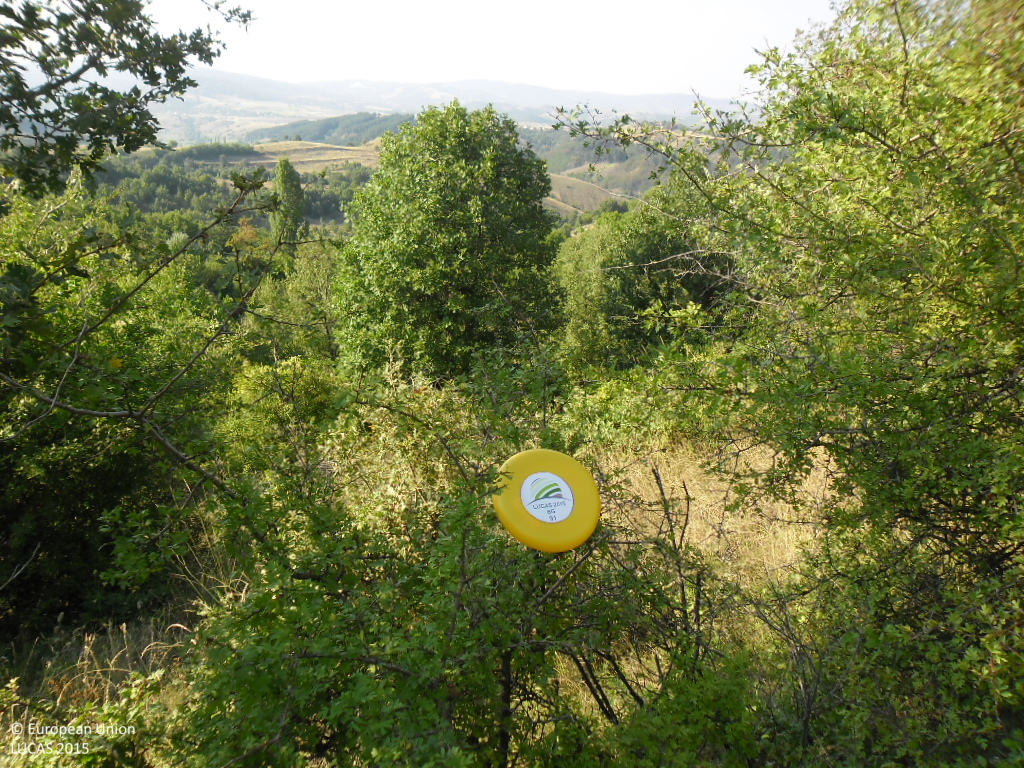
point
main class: Woodland
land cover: Broadleaved woodland
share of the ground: 50 - 75 %
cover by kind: broadleaved forest trees 70 %, herbaceous plants 20 %, shrubs 10 %
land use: Forestry
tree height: < 5 m
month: August
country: BG
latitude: 41.9626
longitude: 22.9685
